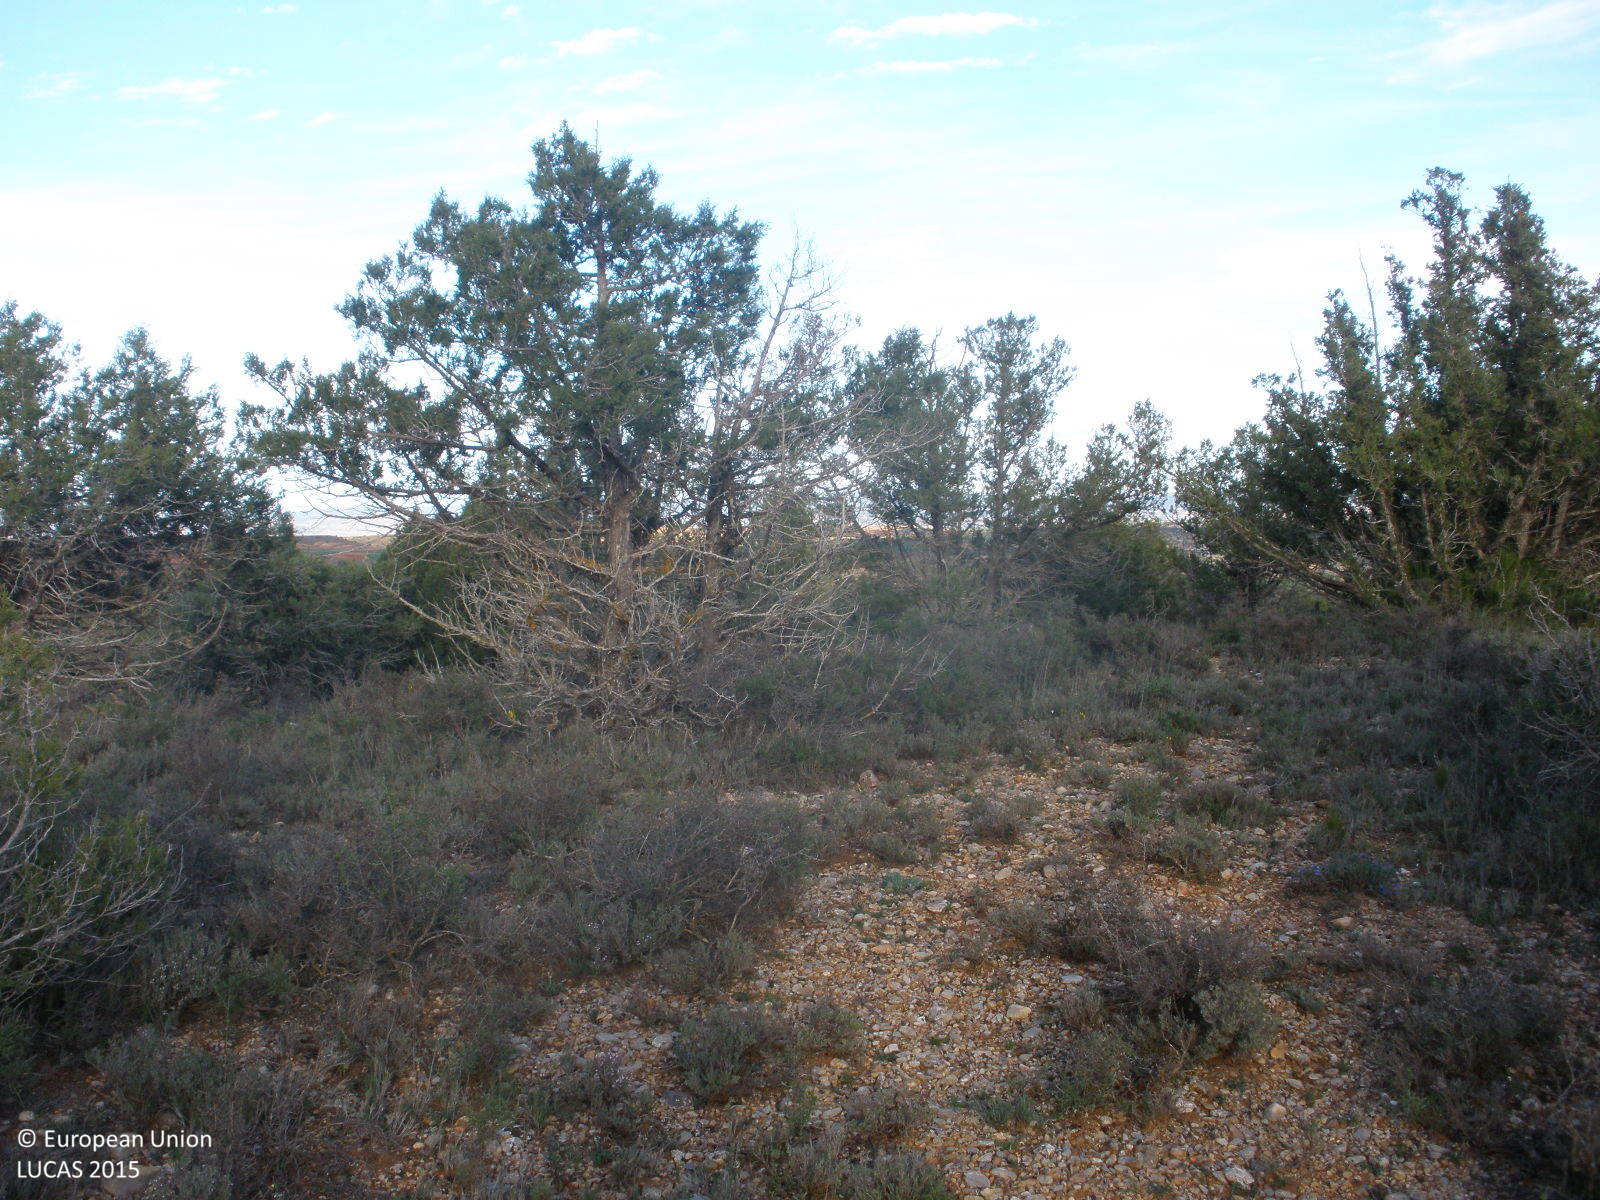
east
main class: Woodland
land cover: Other coniferous woodland
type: coniferous forest of the mediterranean region
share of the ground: 50 - 75 %
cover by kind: coniferous forest trees 60 %, consolidated bare surface 30 %, shrubs 10 %
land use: Semi-natural and natural areas not in use
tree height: < 5 m
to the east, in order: Other coniferous woodland; Rivers and streams; Other coniferous woodland; Shrubland with sparse tree cover
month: April
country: ES
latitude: 40.3832
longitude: -1.2614
